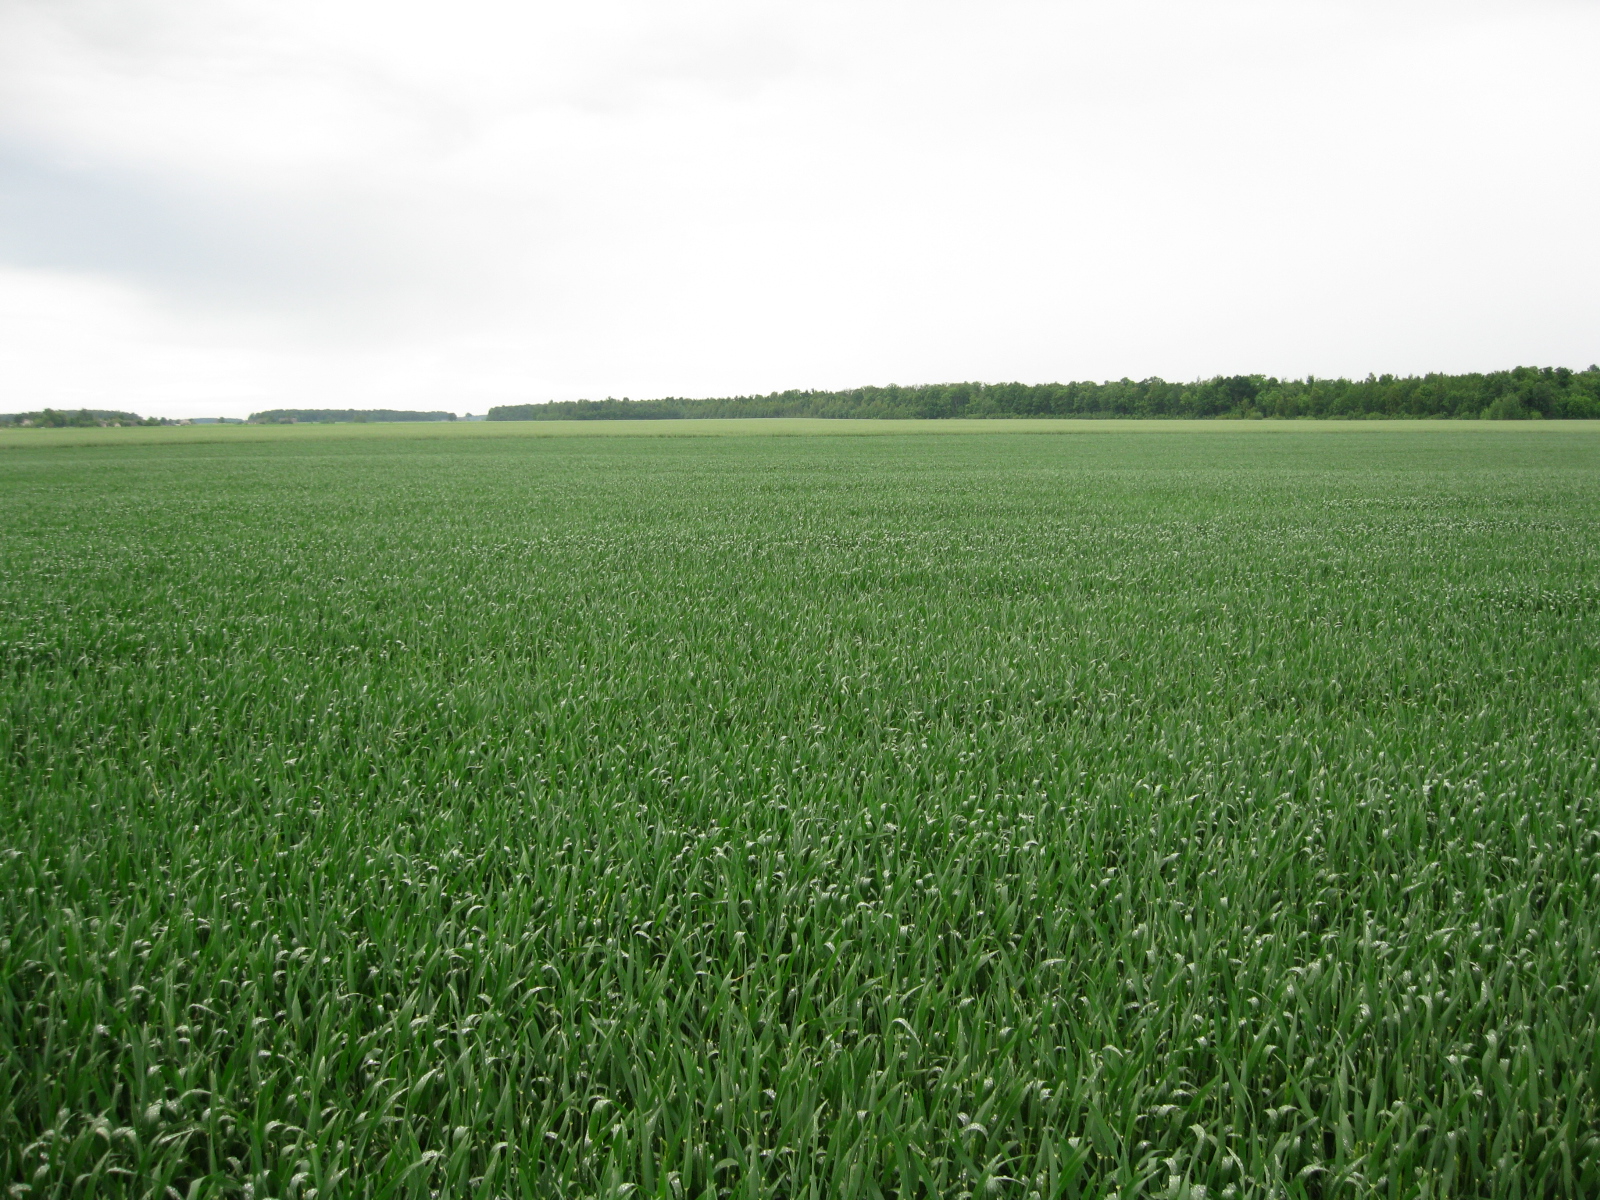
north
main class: Cropland
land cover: Common wheat
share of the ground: > 75 %
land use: Agriculture (excluding fallow land and kitchen gardens)
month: June
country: LT
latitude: 55.4492
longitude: 23.8572
